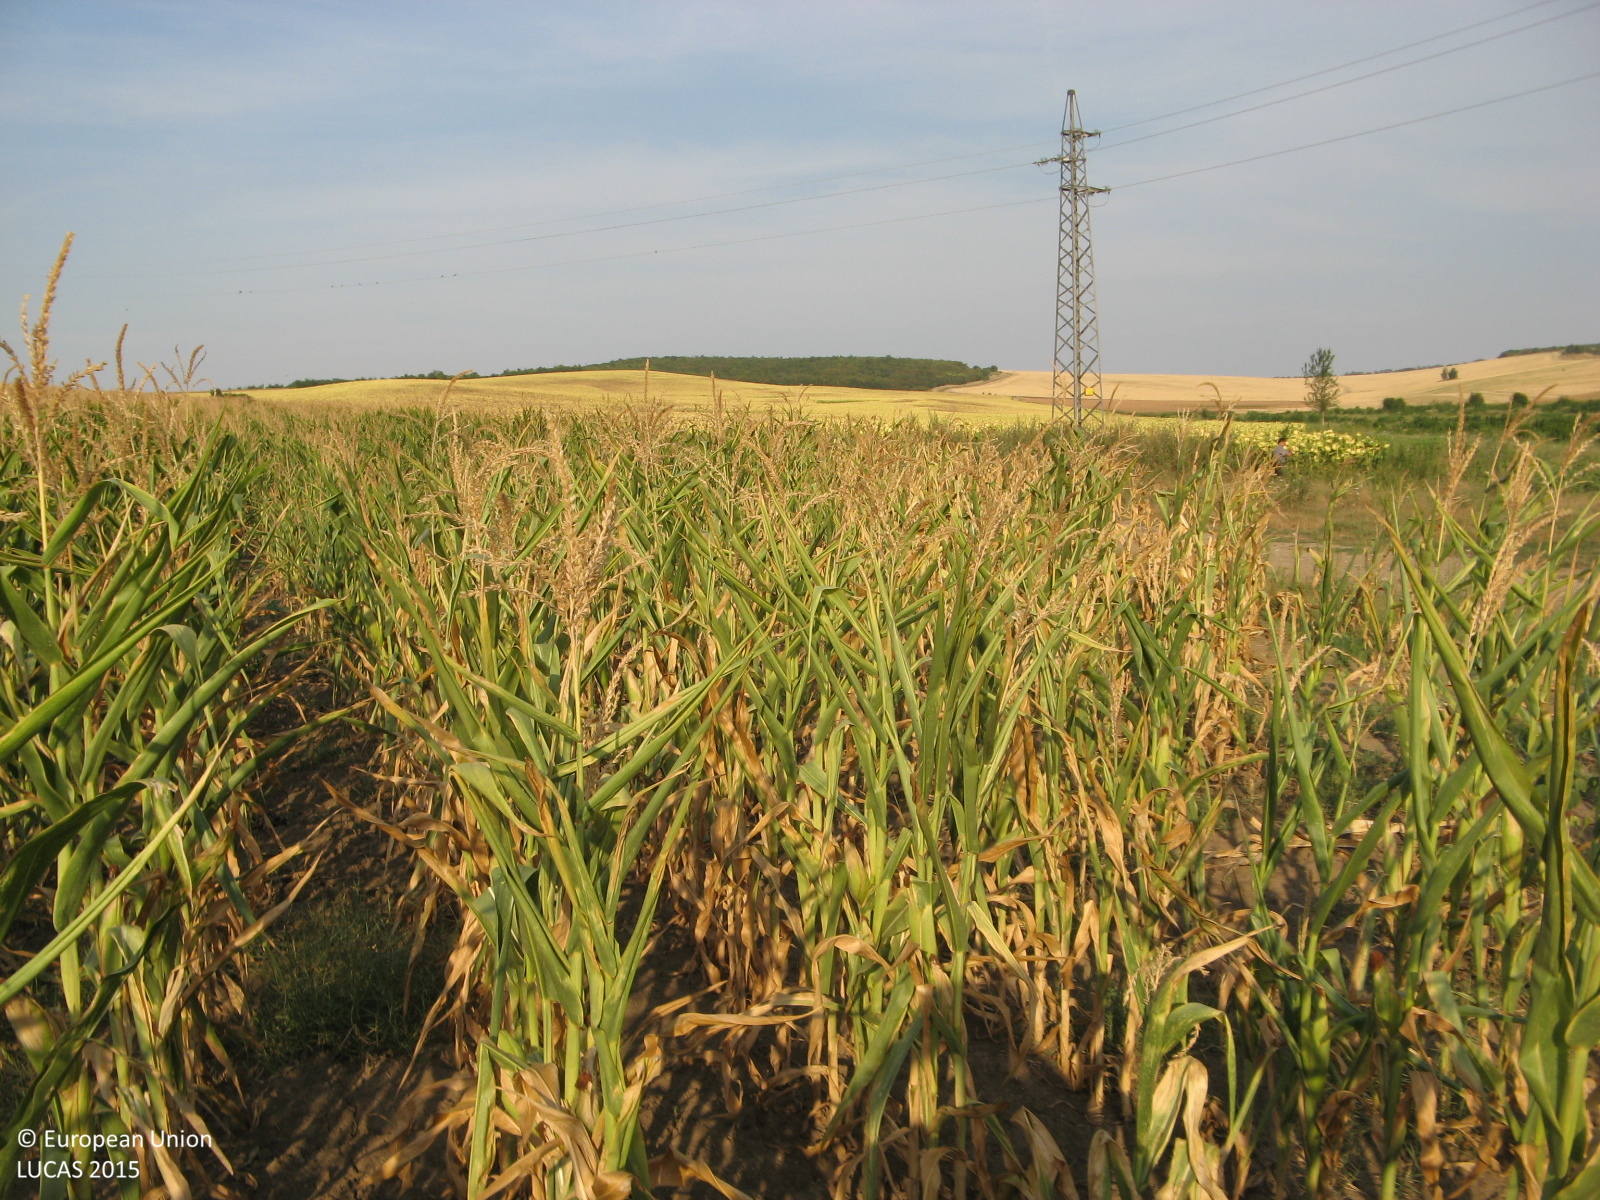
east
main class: Cropland
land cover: Maize
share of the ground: > 75 %
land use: Agriculture (excluding fallow land and kitchen gardens)
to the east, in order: Maize
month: August
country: BG
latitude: 43.4481
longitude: 25.2879
